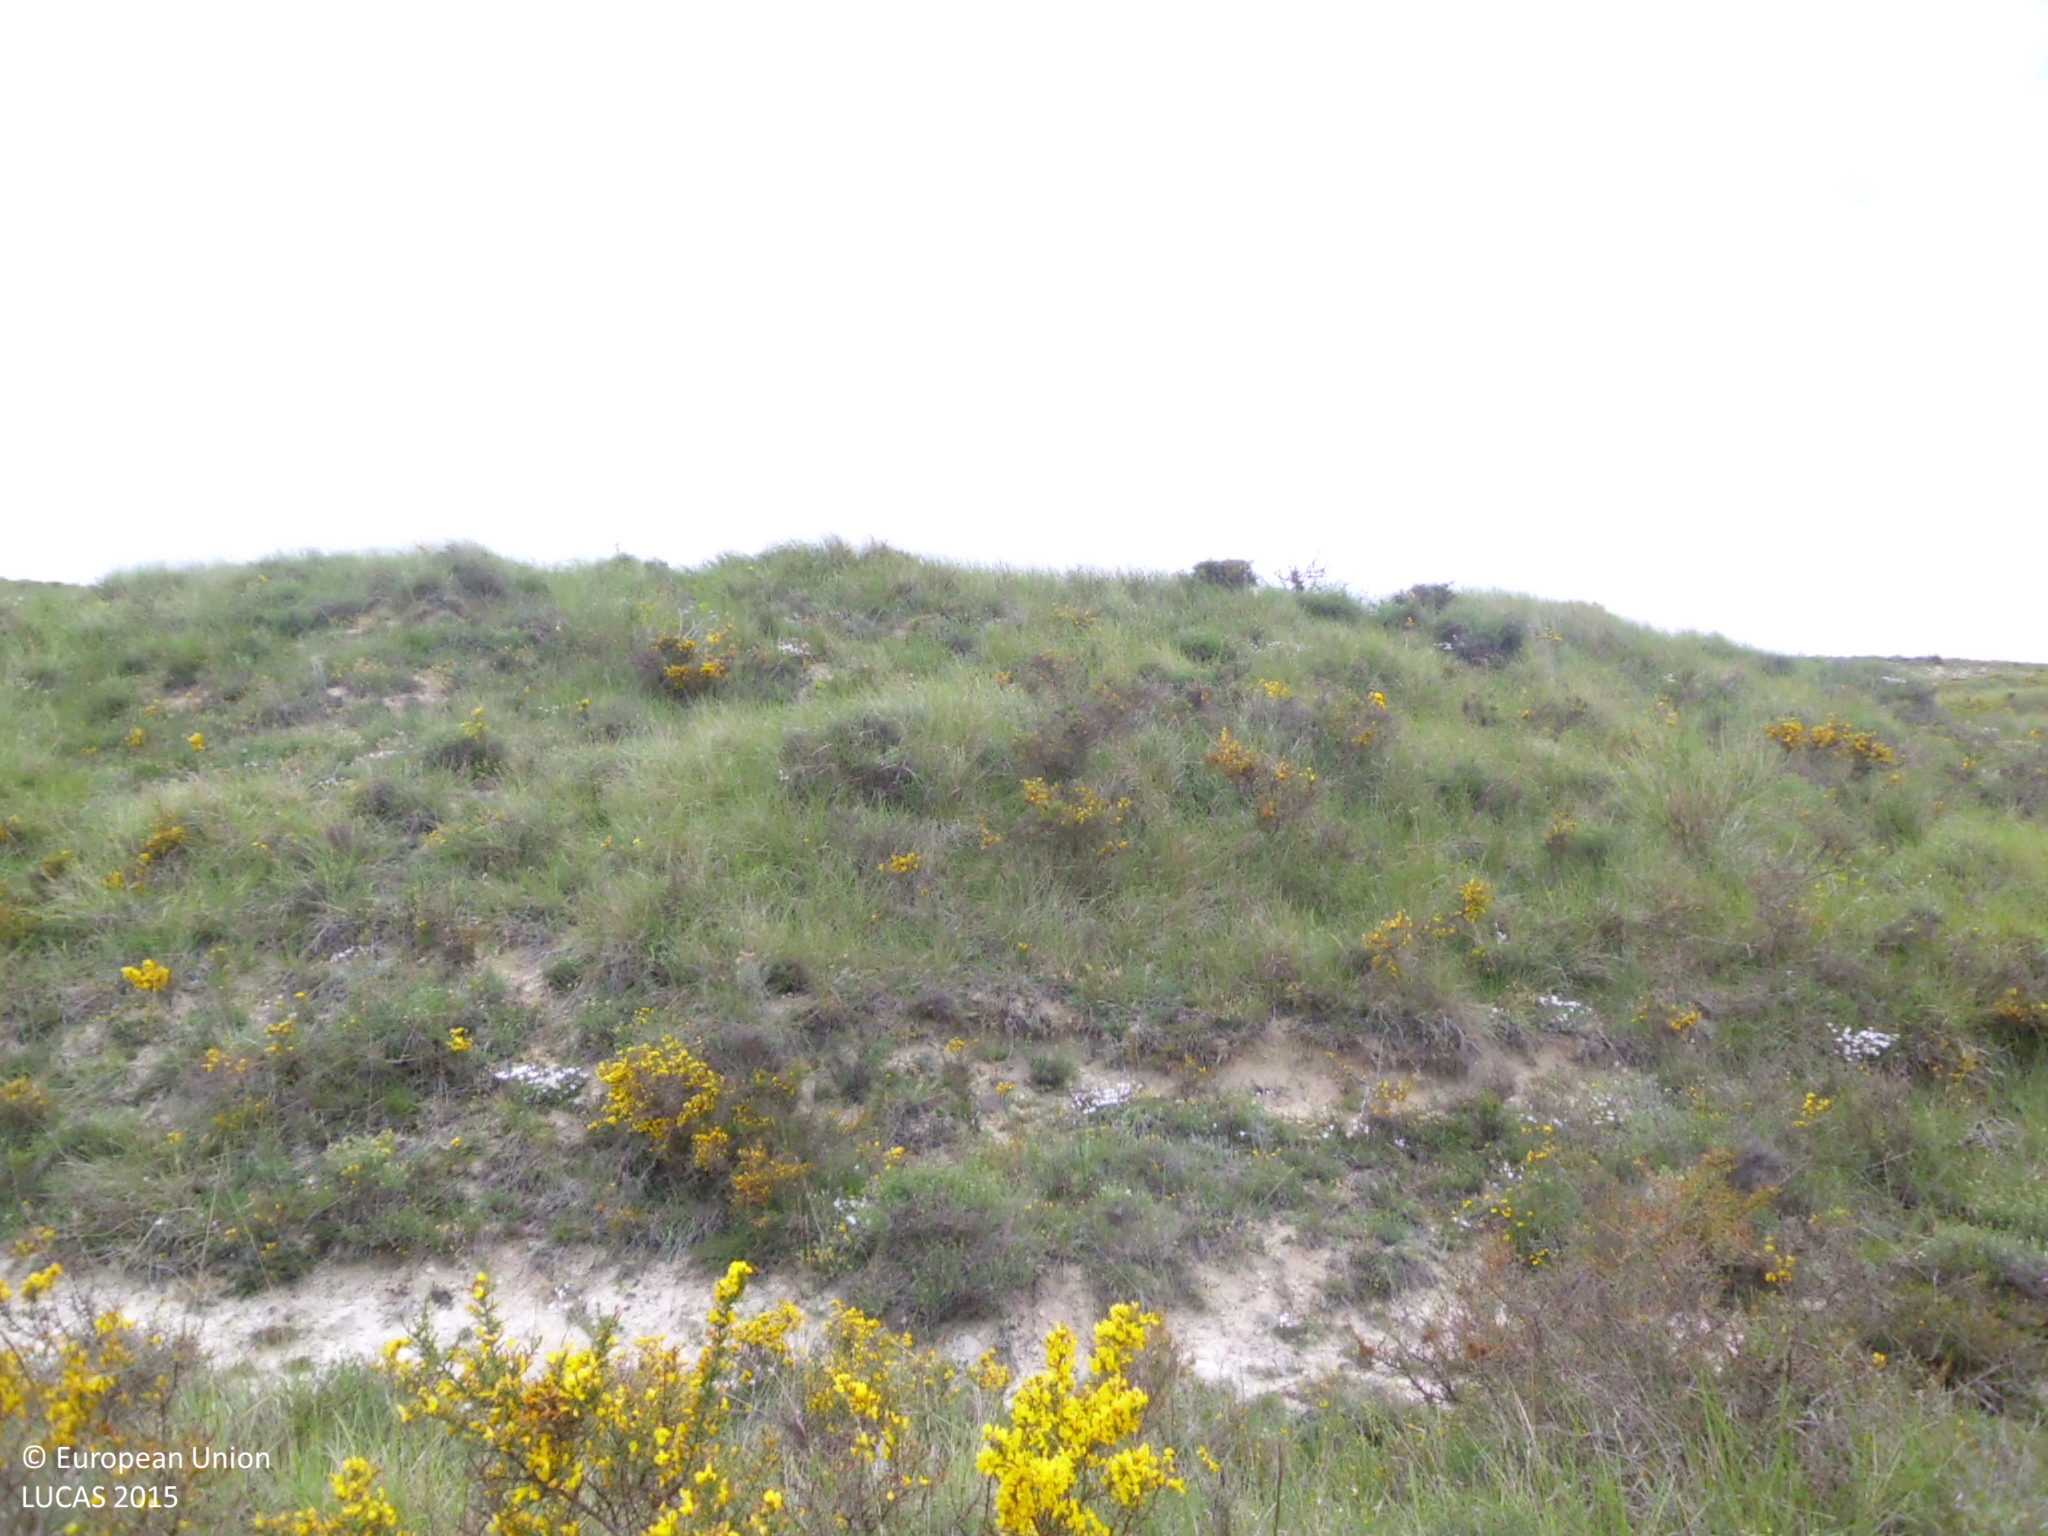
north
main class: Shrubland
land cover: Shrubland without tree cover
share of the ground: > 75 %
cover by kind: shrubs 60 %, herbaceous plants 40 %
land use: Semi-natural and natural areas not in use
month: May
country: ES
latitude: 42.5242
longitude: -3.9562
